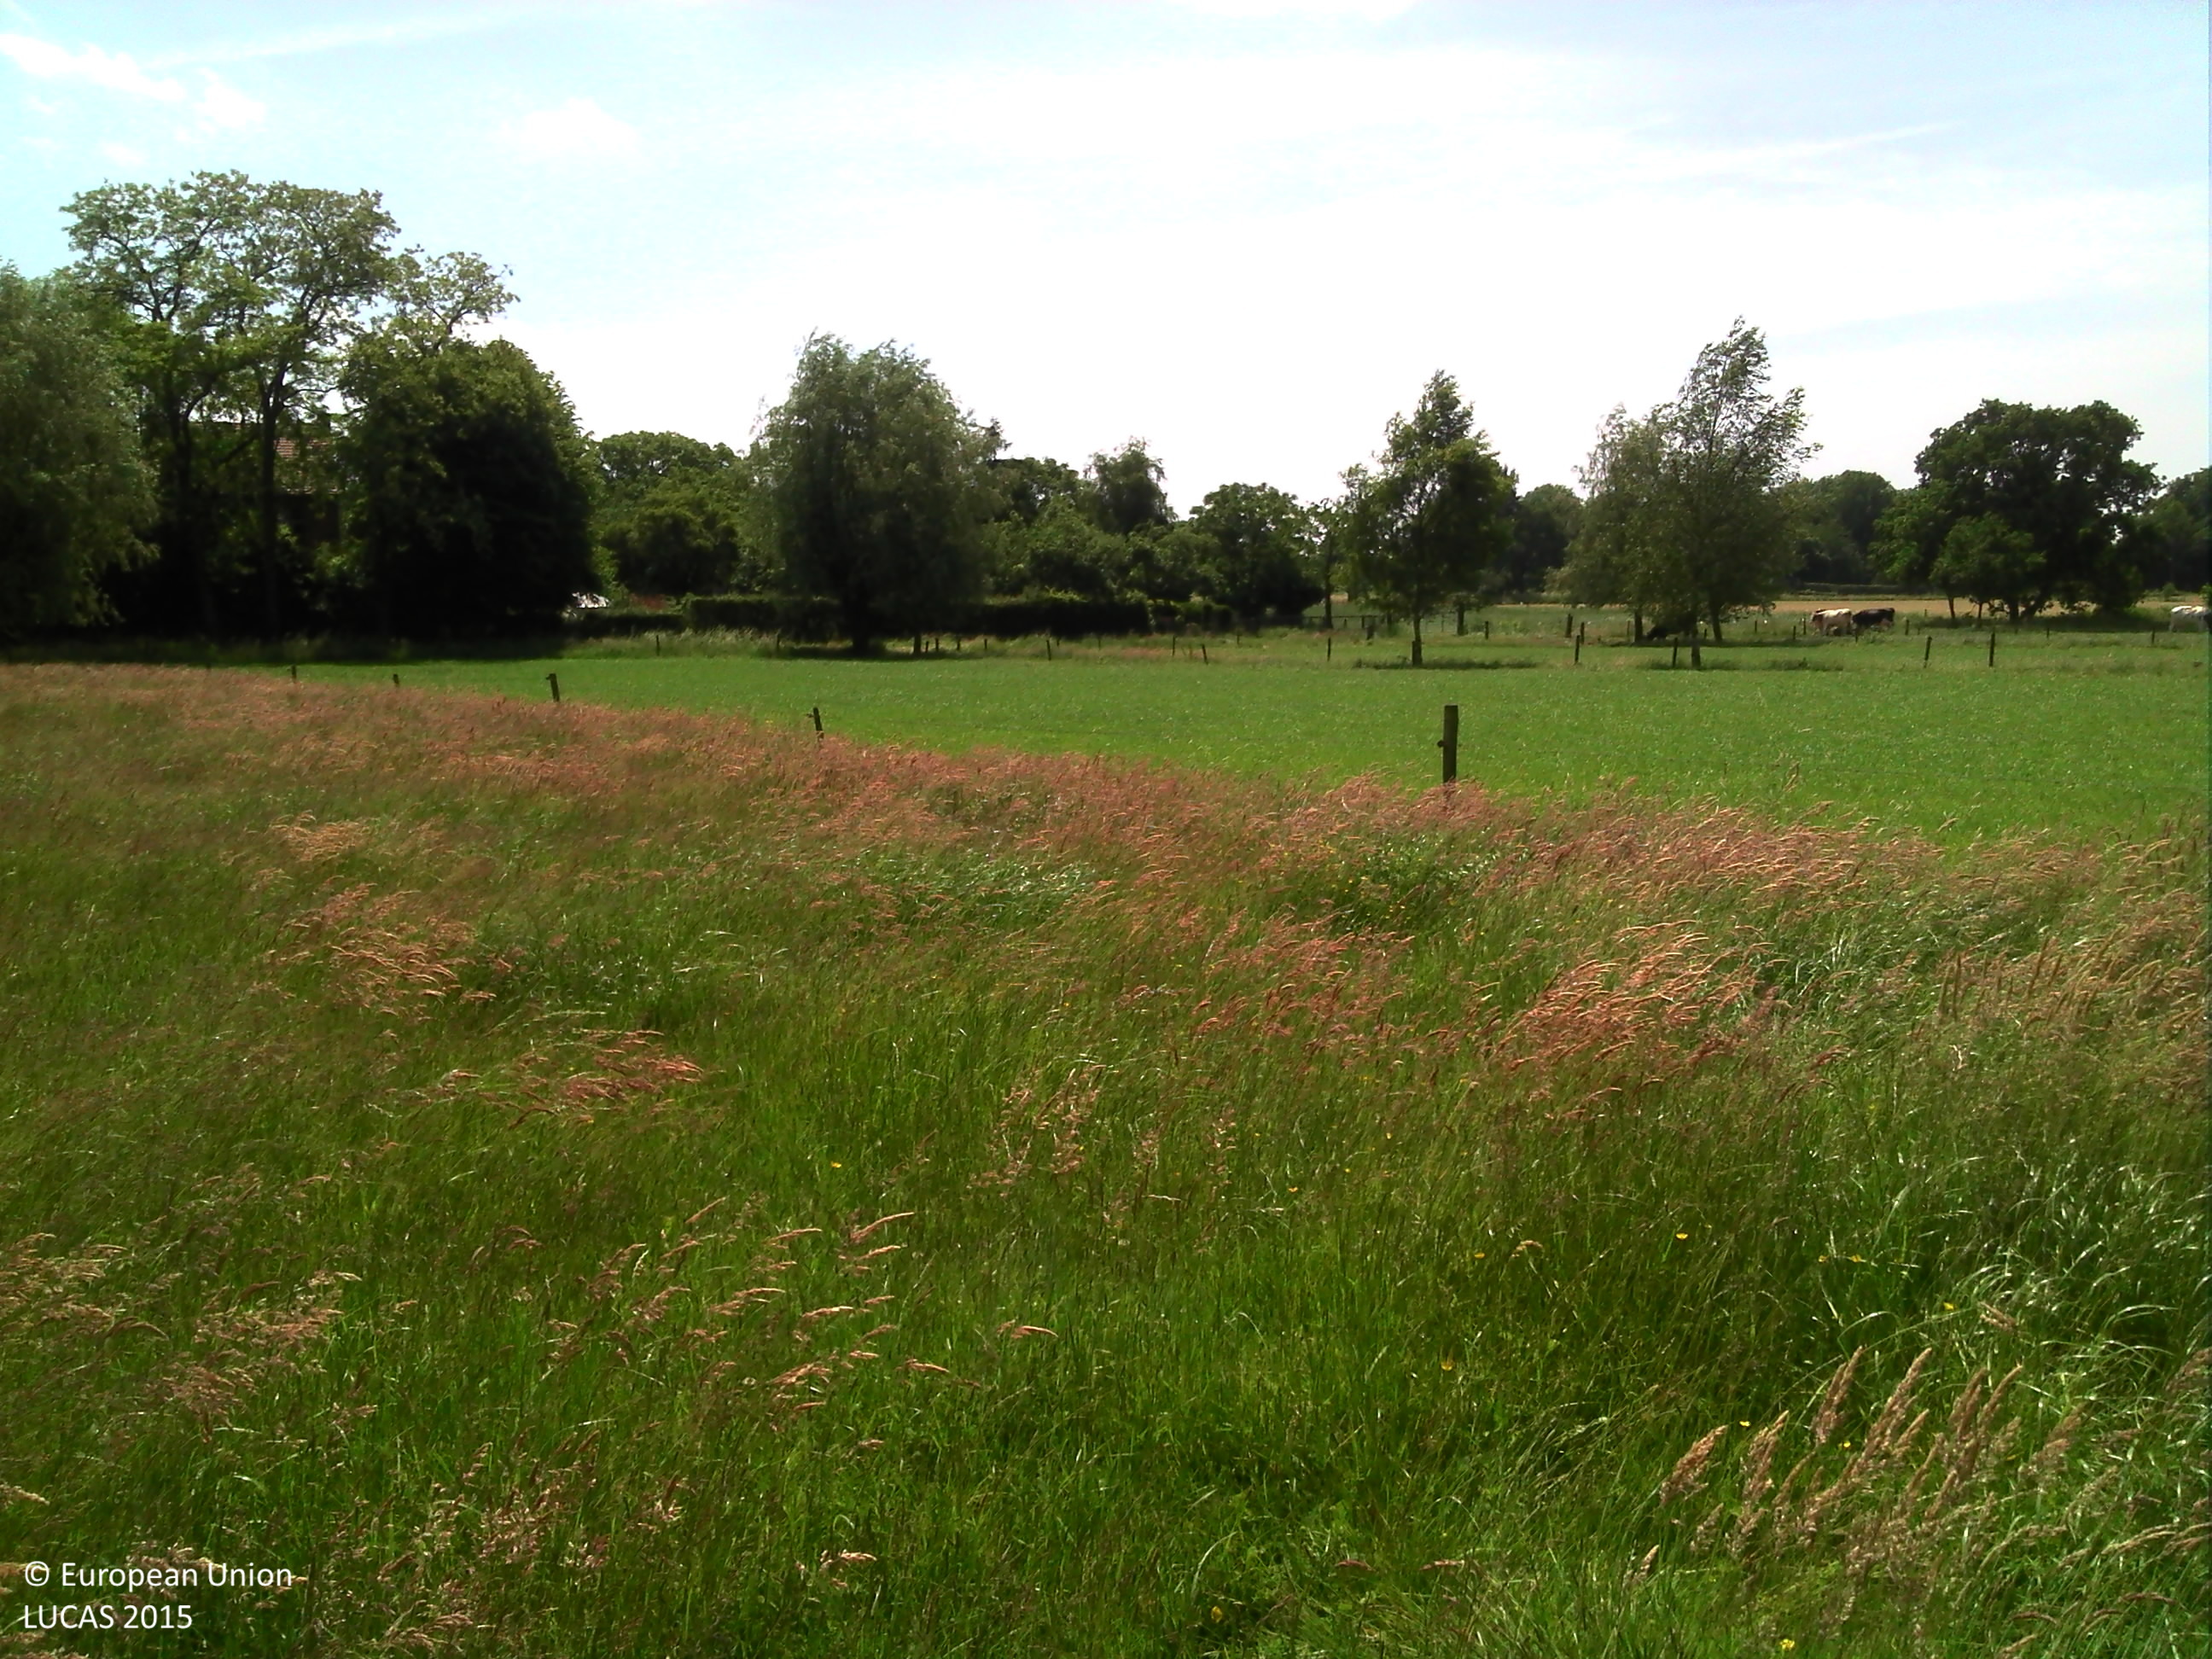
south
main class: Grassland
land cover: Grassland without tree/shrub cover
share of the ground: > 75 %
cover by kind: herbaceous plants 100 %
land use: Agriculture (excluding fallow land and kitchen gardens)
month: June
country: BE
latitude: 51.0005
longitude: 5.1668
